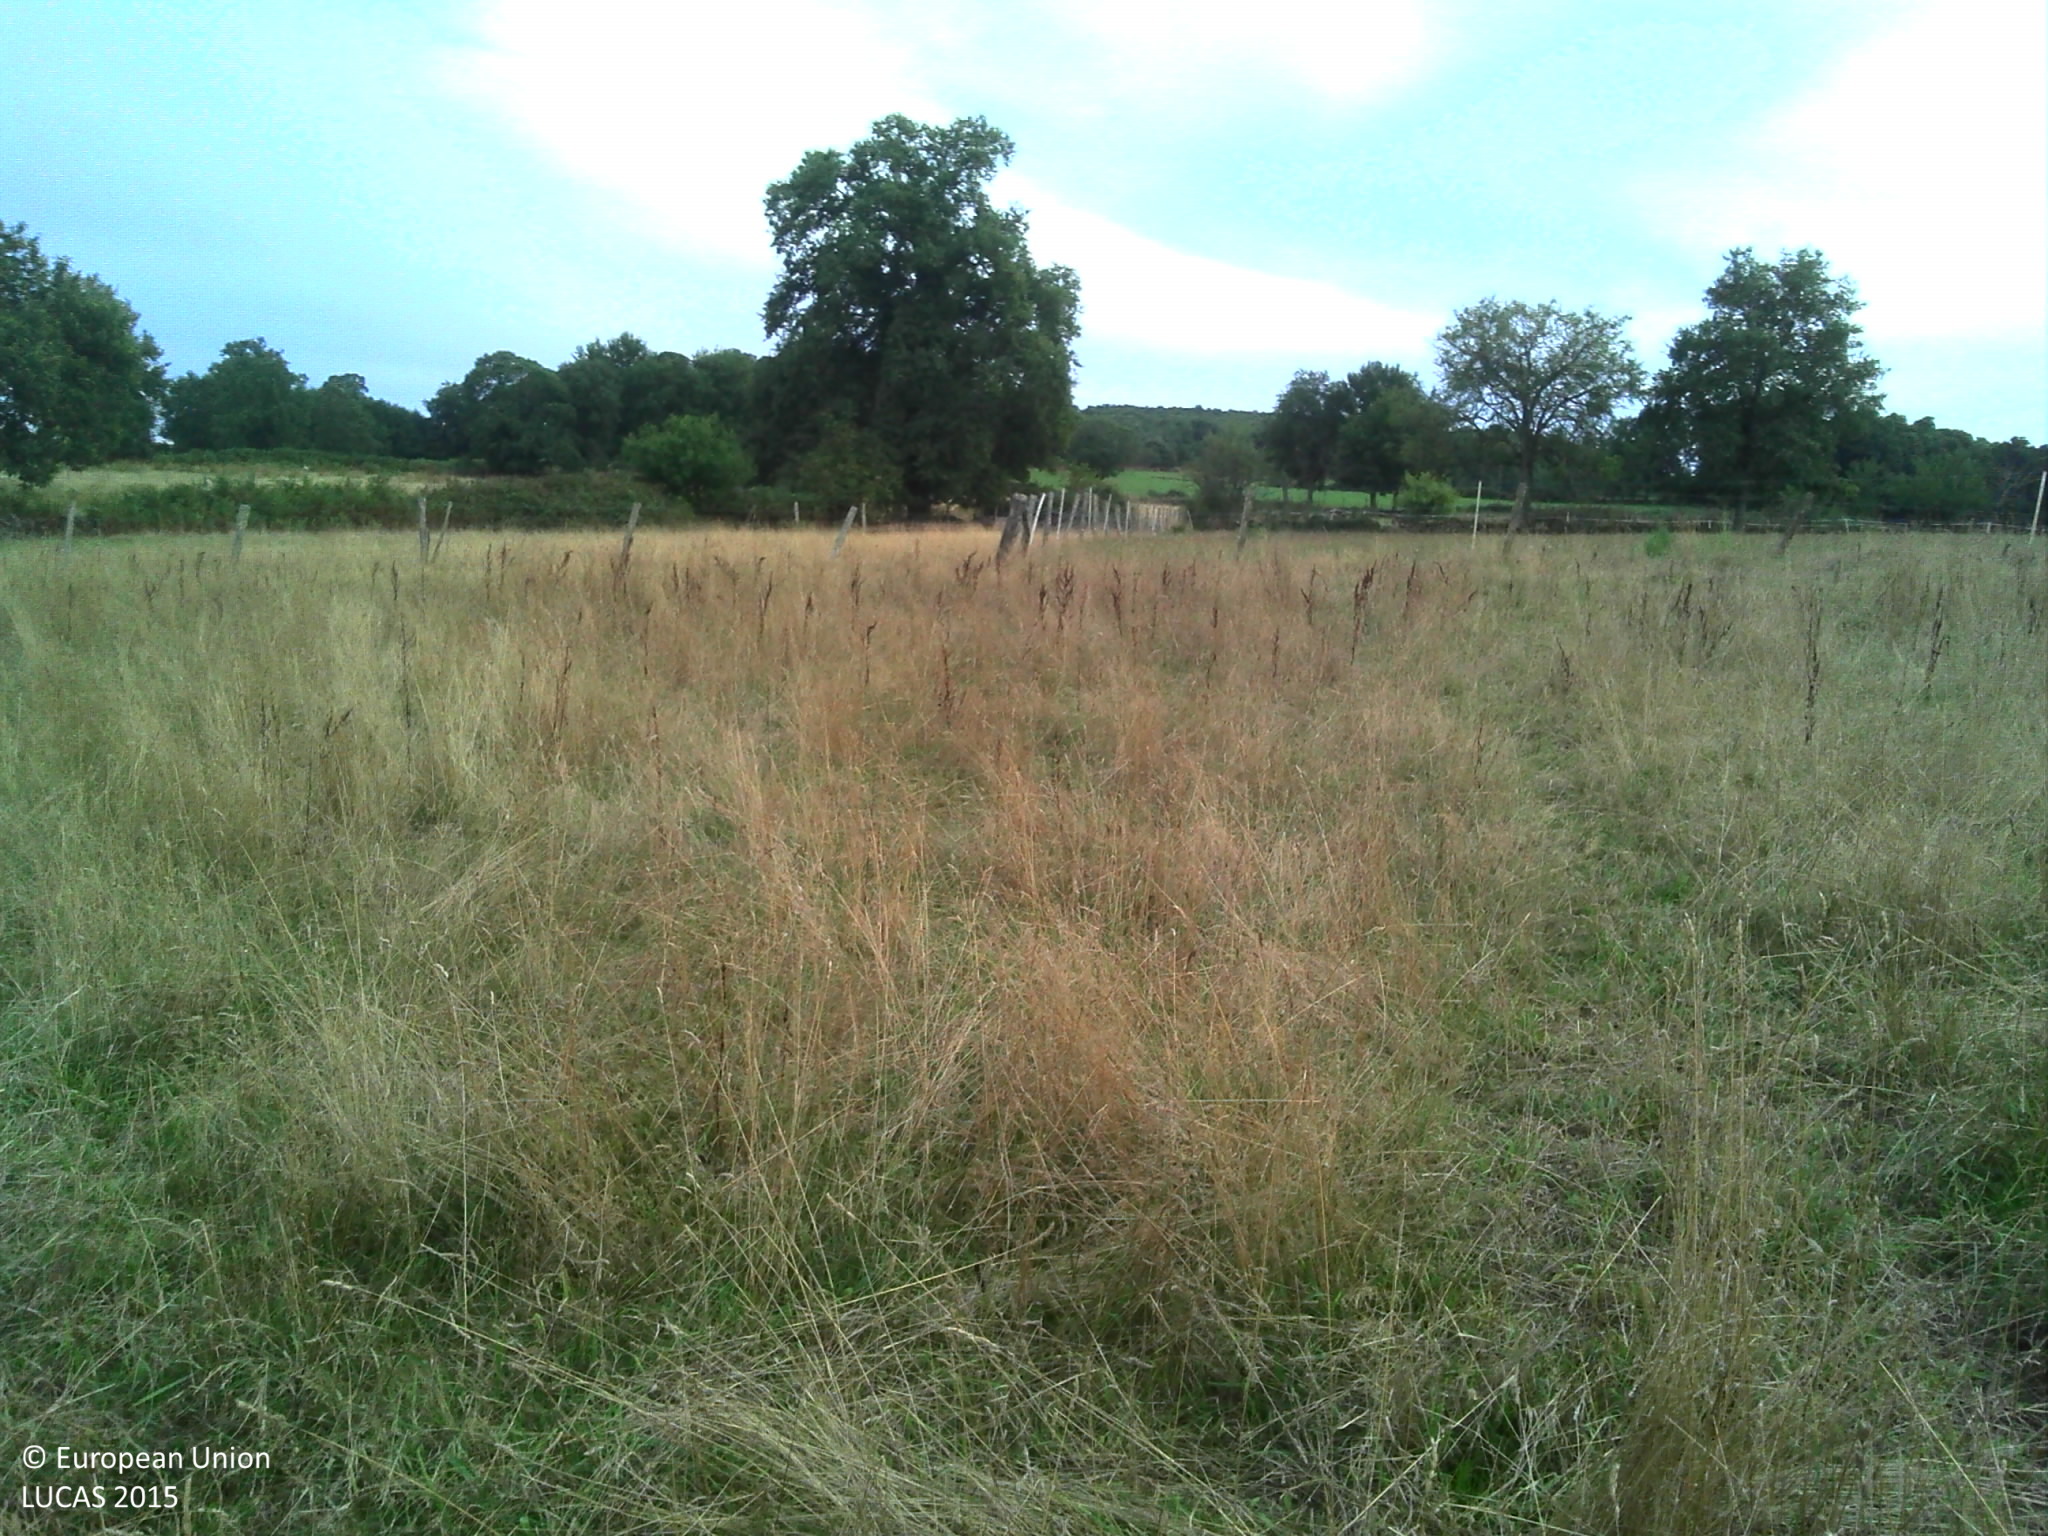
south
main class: Grassland
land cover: Grassland without tree/shrub cover
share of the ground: > 75 %
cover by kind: herbaceous plants 100 %
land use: Agriculture (excluding fallow land and kitchen gardens)
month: August
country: FR
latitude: 46.1214
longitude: 1.2806
